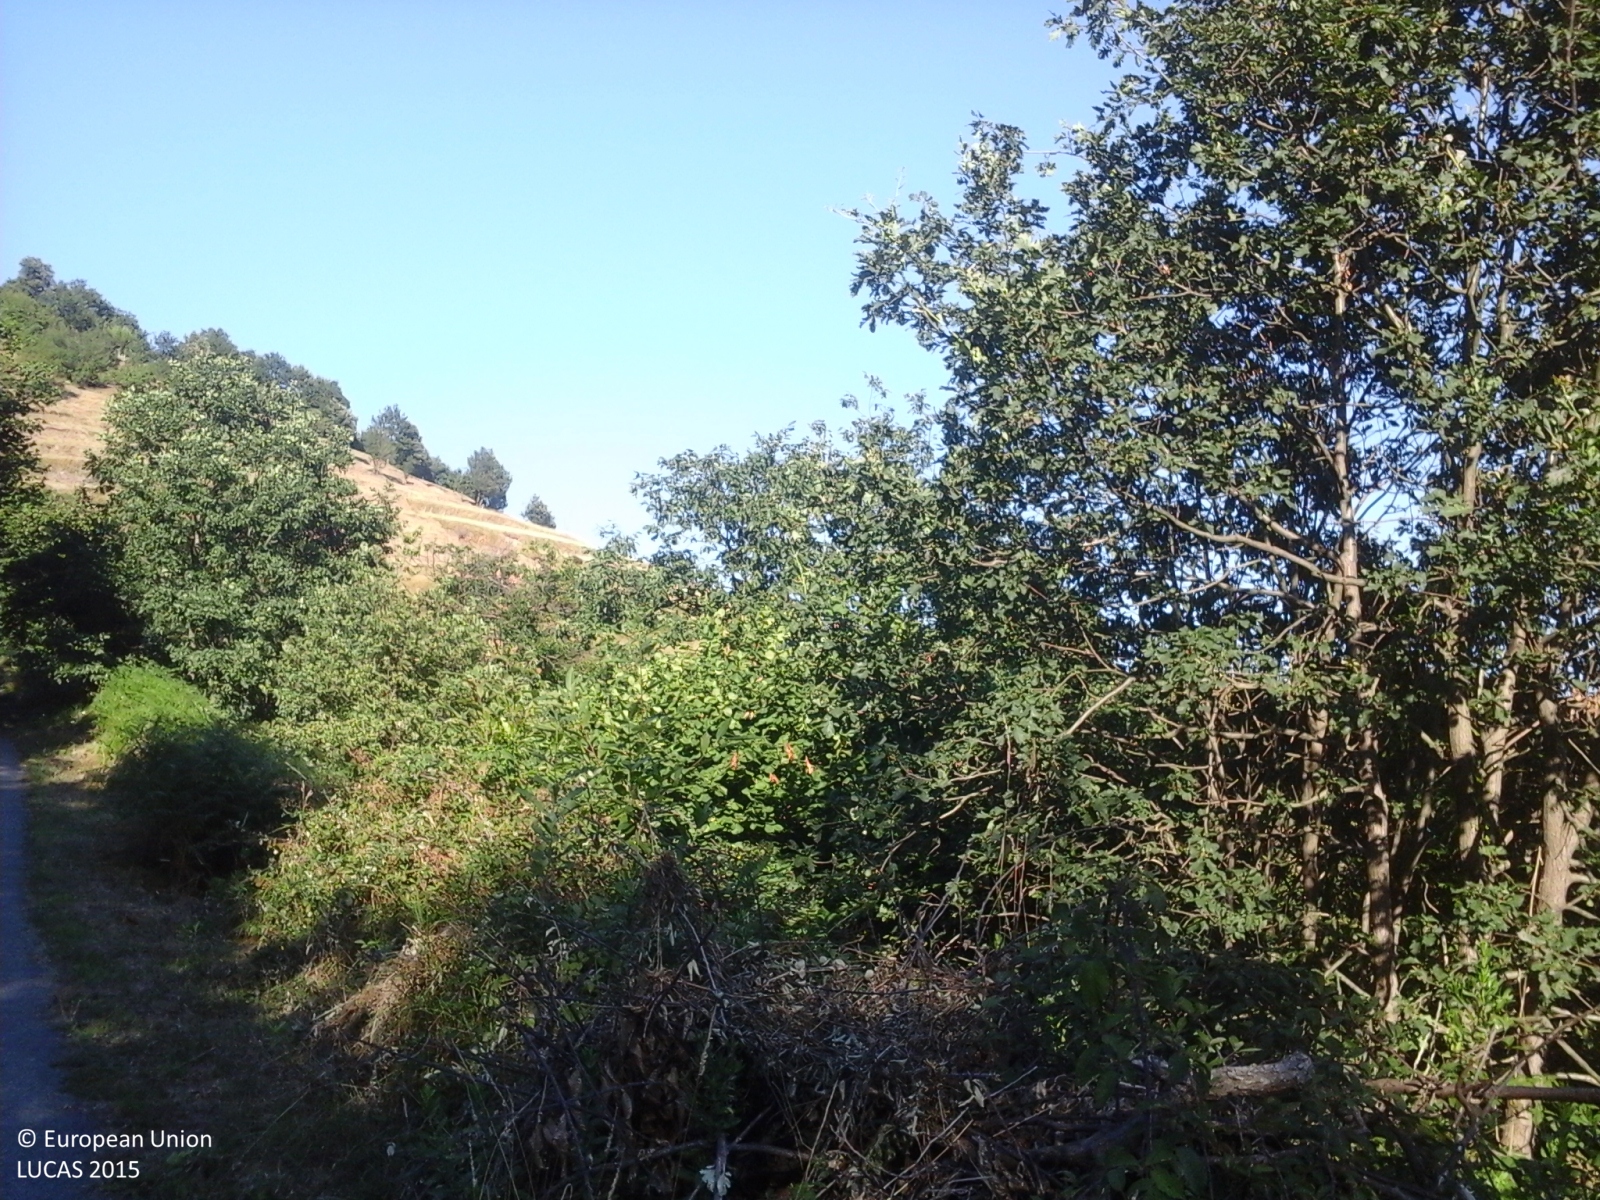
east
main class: Woodland
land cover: Broadleaved woodland
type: thermophilous deciduous forest
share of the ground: > 75 %
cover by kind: broadleaved forest trees 80 %, shrubs 10 %, coniferous forest trees 5 %, herbaceous plants 5 %
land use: Semi-natural and natural areas not in use
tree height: > 5 m
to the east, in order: Broadleaved woodland; Grassland with sparse tree/shrub cover; Paved roads, cycling and walking lanes; Broadleaved woodland; Paved roads, cycling and walking lanes; Grassland with sparse tree/shrub cover
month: August
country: IT
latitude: 44.4688
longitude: 8.7081
